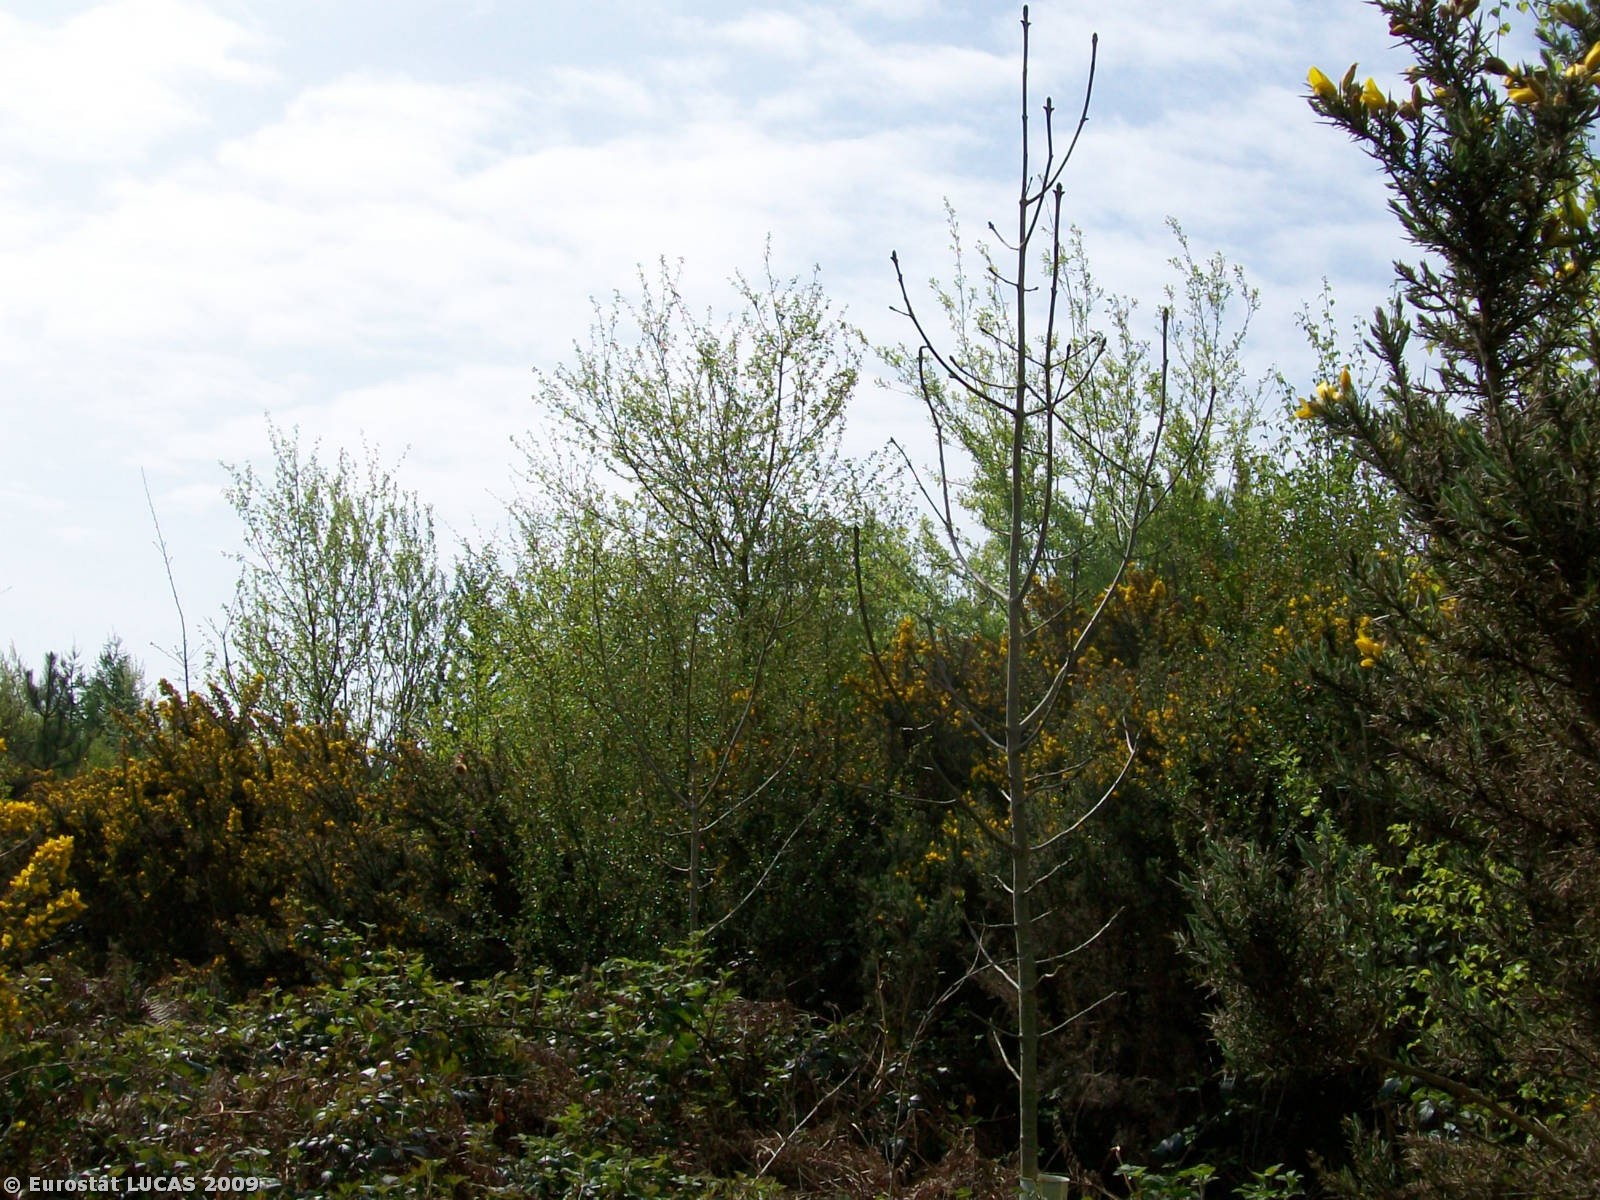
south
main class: Woodland
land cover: Mixed woodland
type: plantations and self-sown exotic forest
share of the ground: 50 - 75 %
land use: Amenities, museums, leisure
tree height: > 5 m
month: April
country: GB
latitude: 50.6336
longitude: -3.3570
